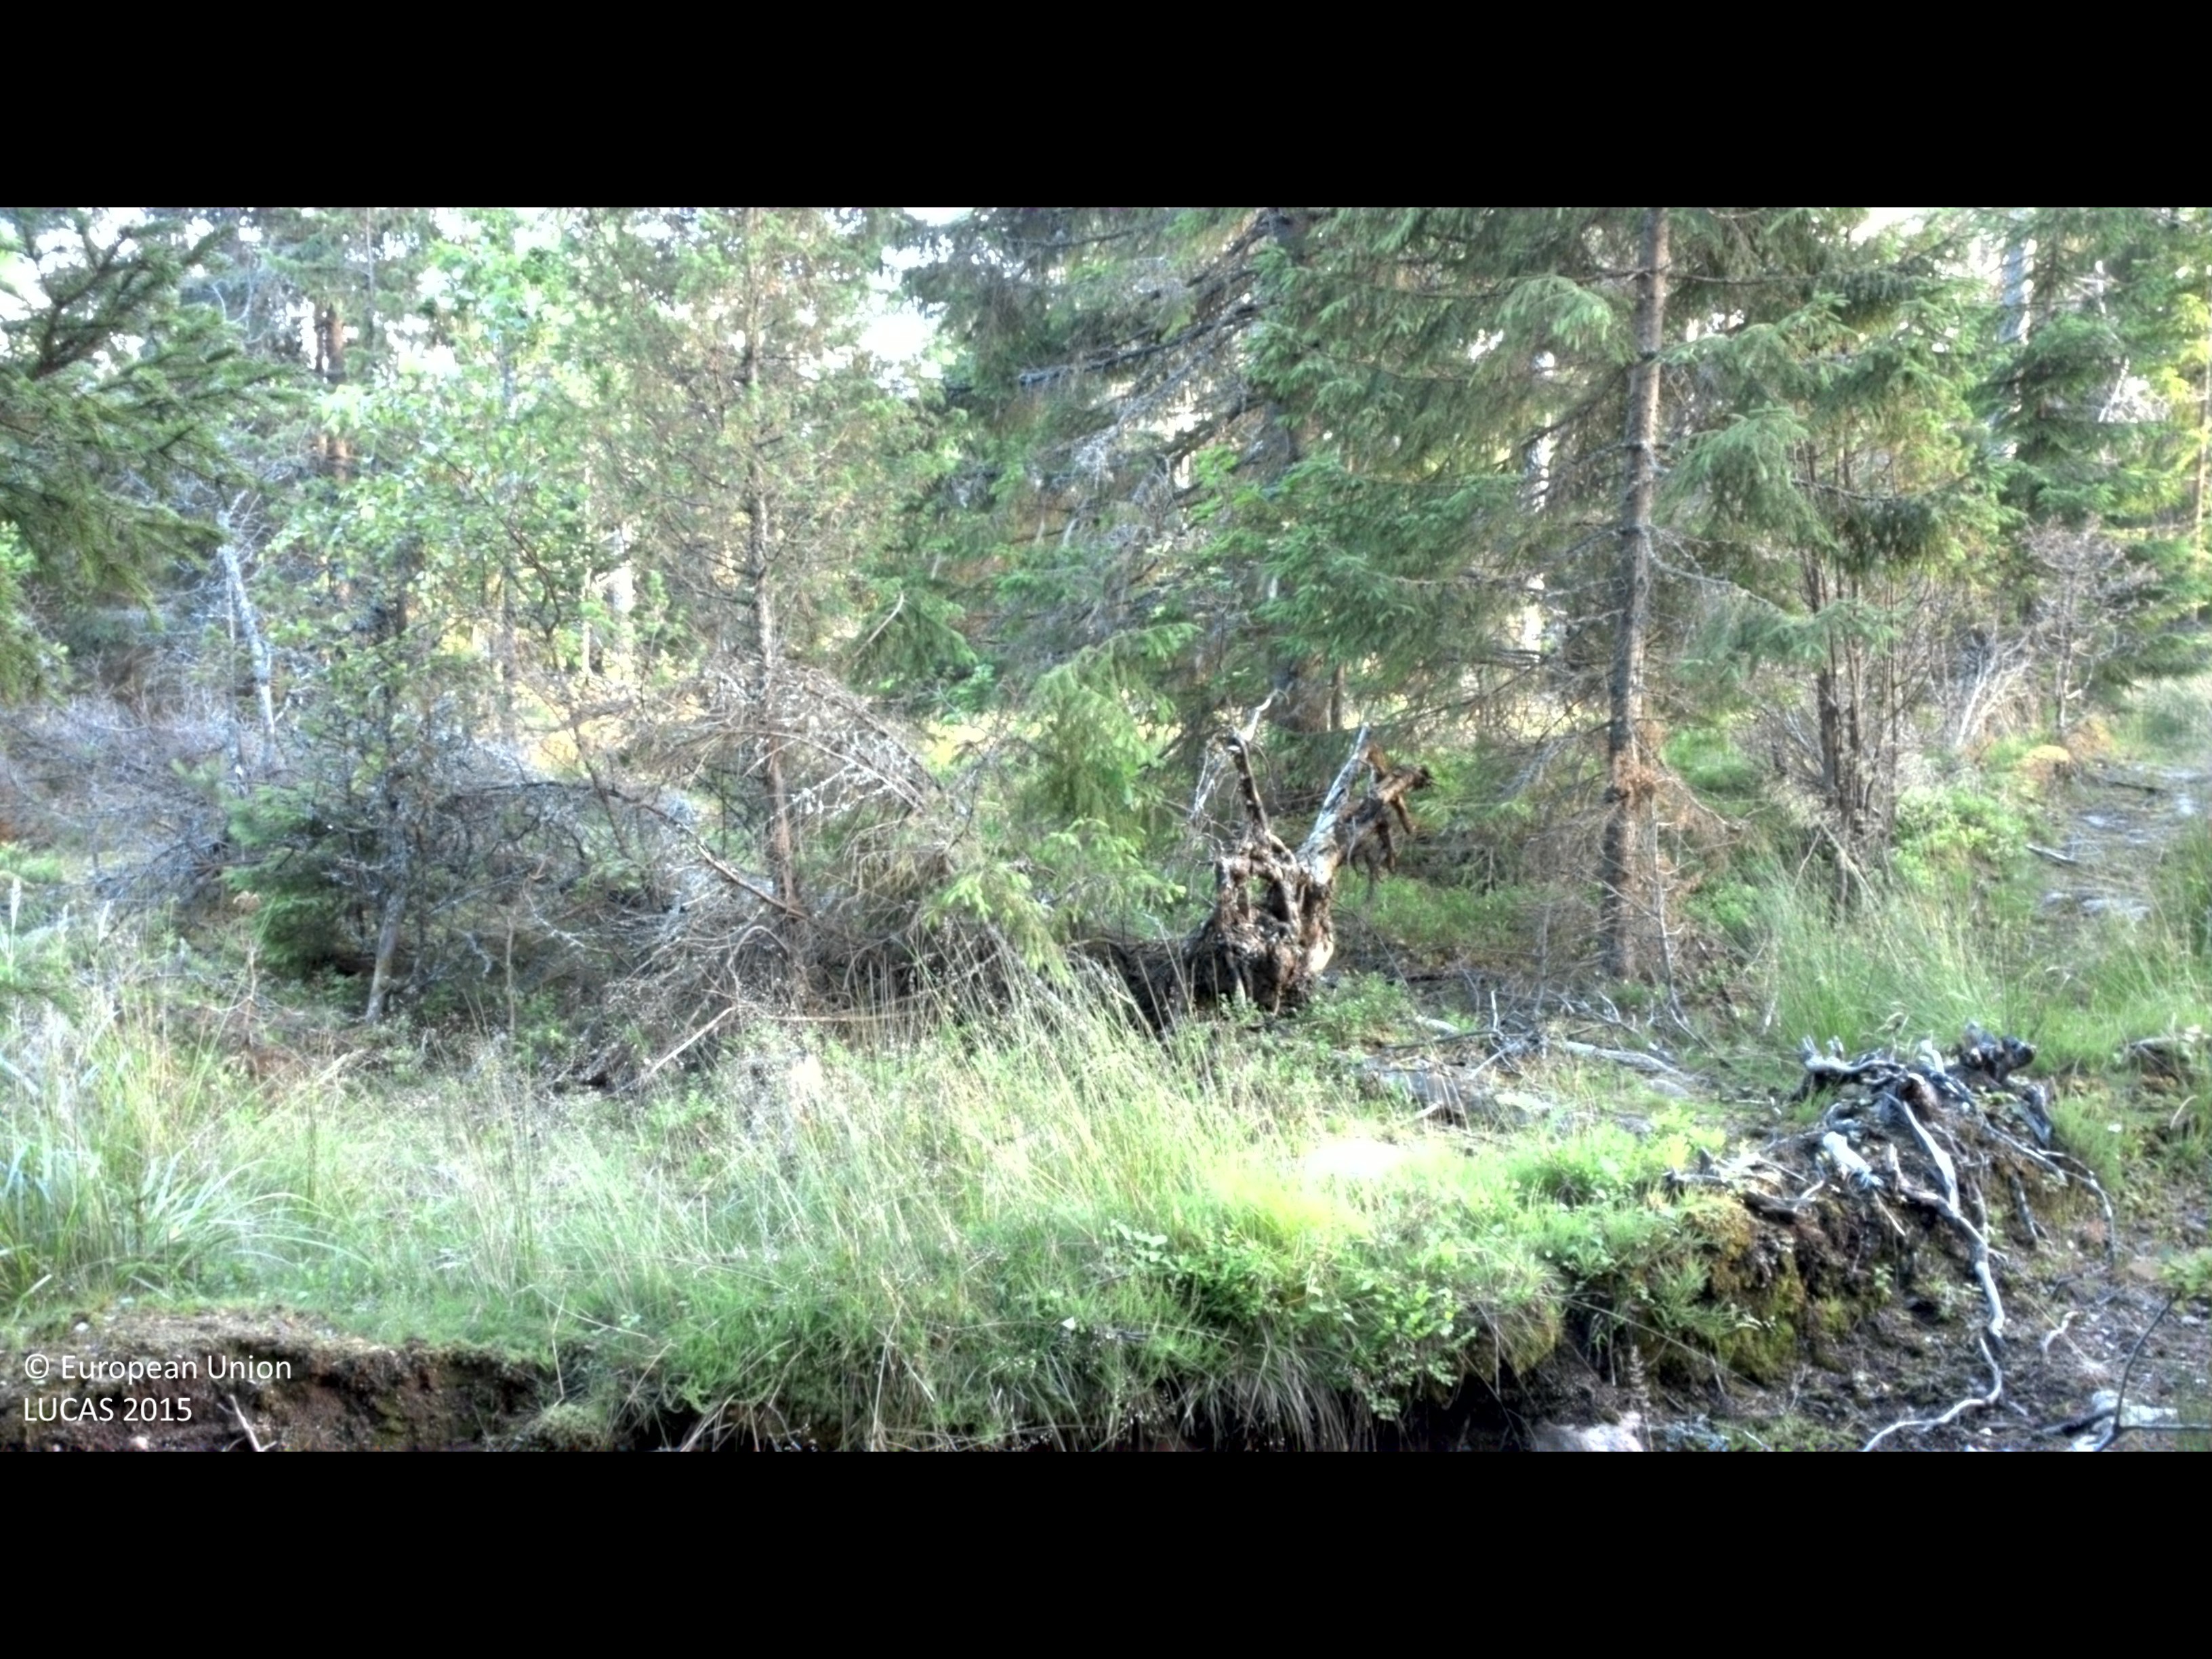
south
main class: Woodland
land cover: Spruce dominated coniferous woodland
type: boreal forest
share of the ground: 50 - 75 %
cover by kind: coniferous forest trees 55 %, shrubs 35 %, broadleaved forest trees 5 %, herbaceous plants 5 %
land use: Forestry
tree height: > 5 m
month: July
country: SE
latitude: 58.0740
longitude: 16.2529
